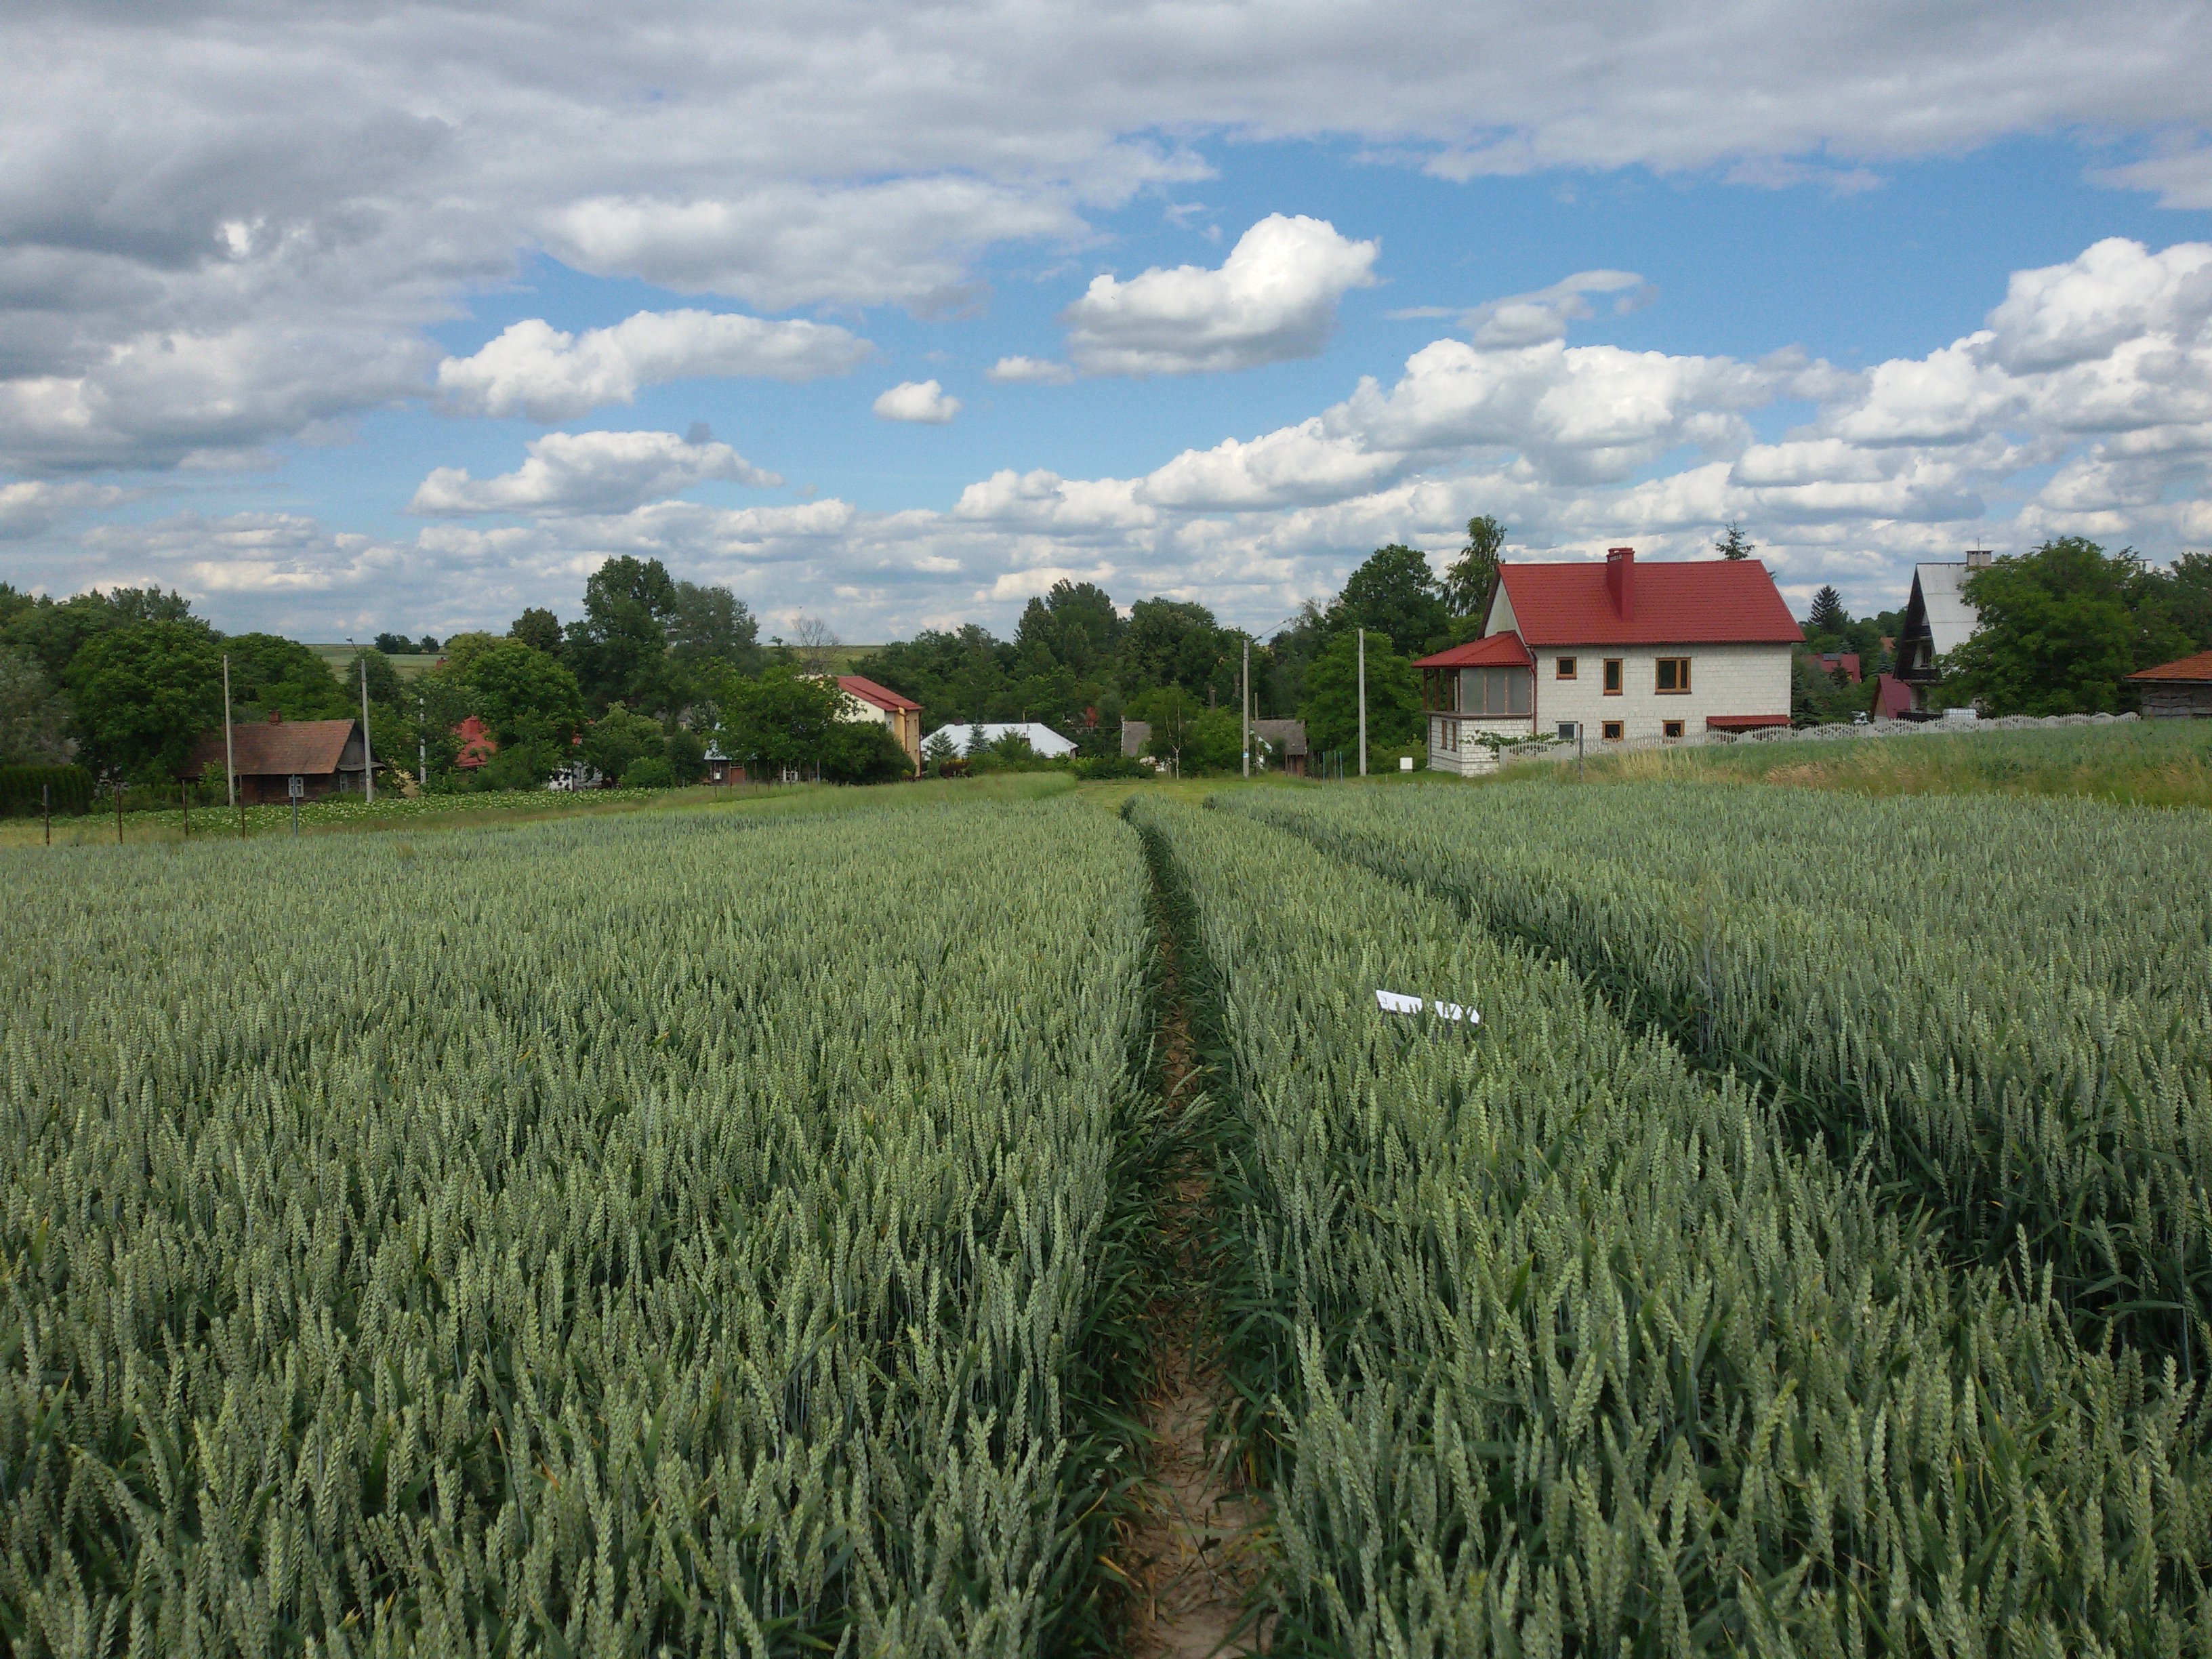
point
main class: Cropland
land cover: Common wheat
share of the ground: > 75 %
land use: Agriculture (excluding fallow land and kitchen gardens)
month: June
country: PL
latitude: 50.0566
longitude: 22.3402
